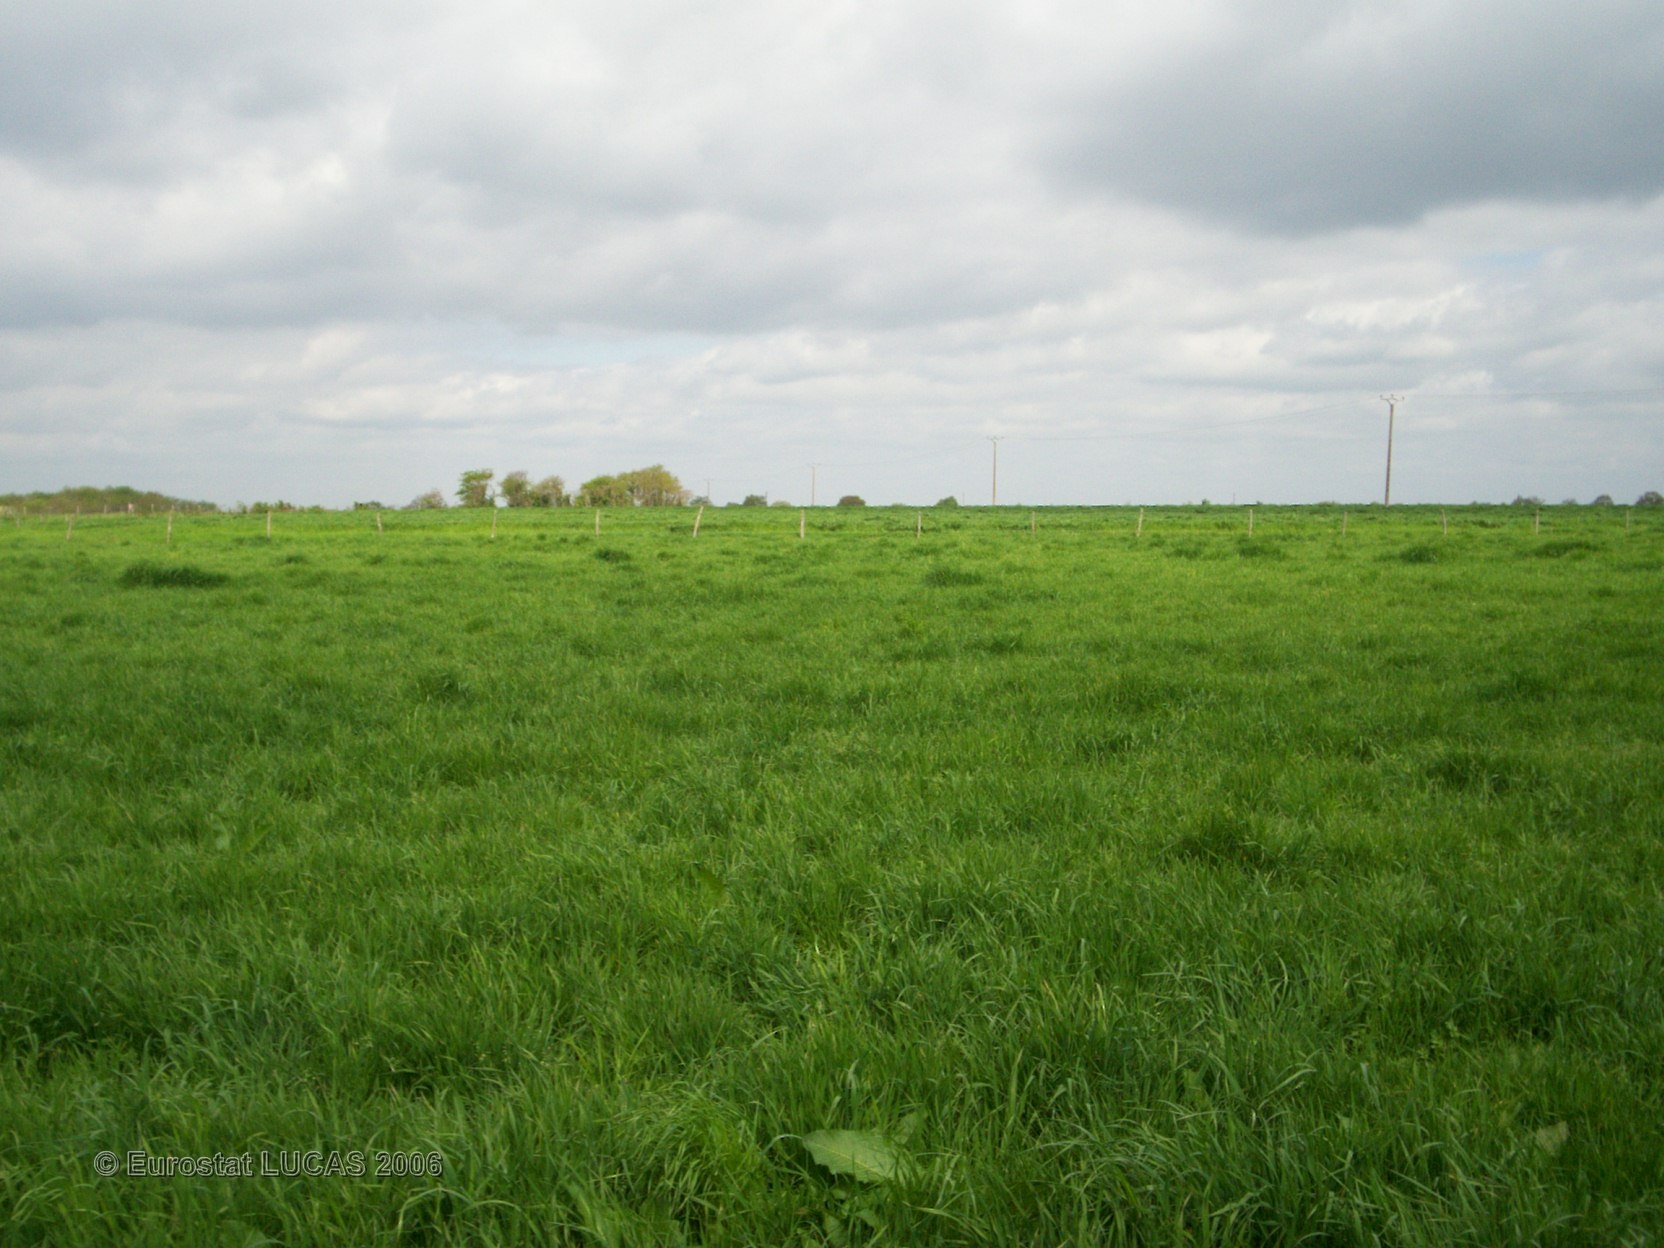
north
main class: Grassland
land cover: Grassland without tree/shrub cover
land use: Agriculture (excluding fallow land and kitchen gardens)
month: April
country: FR
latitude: 46.8286
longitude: -1.2449
